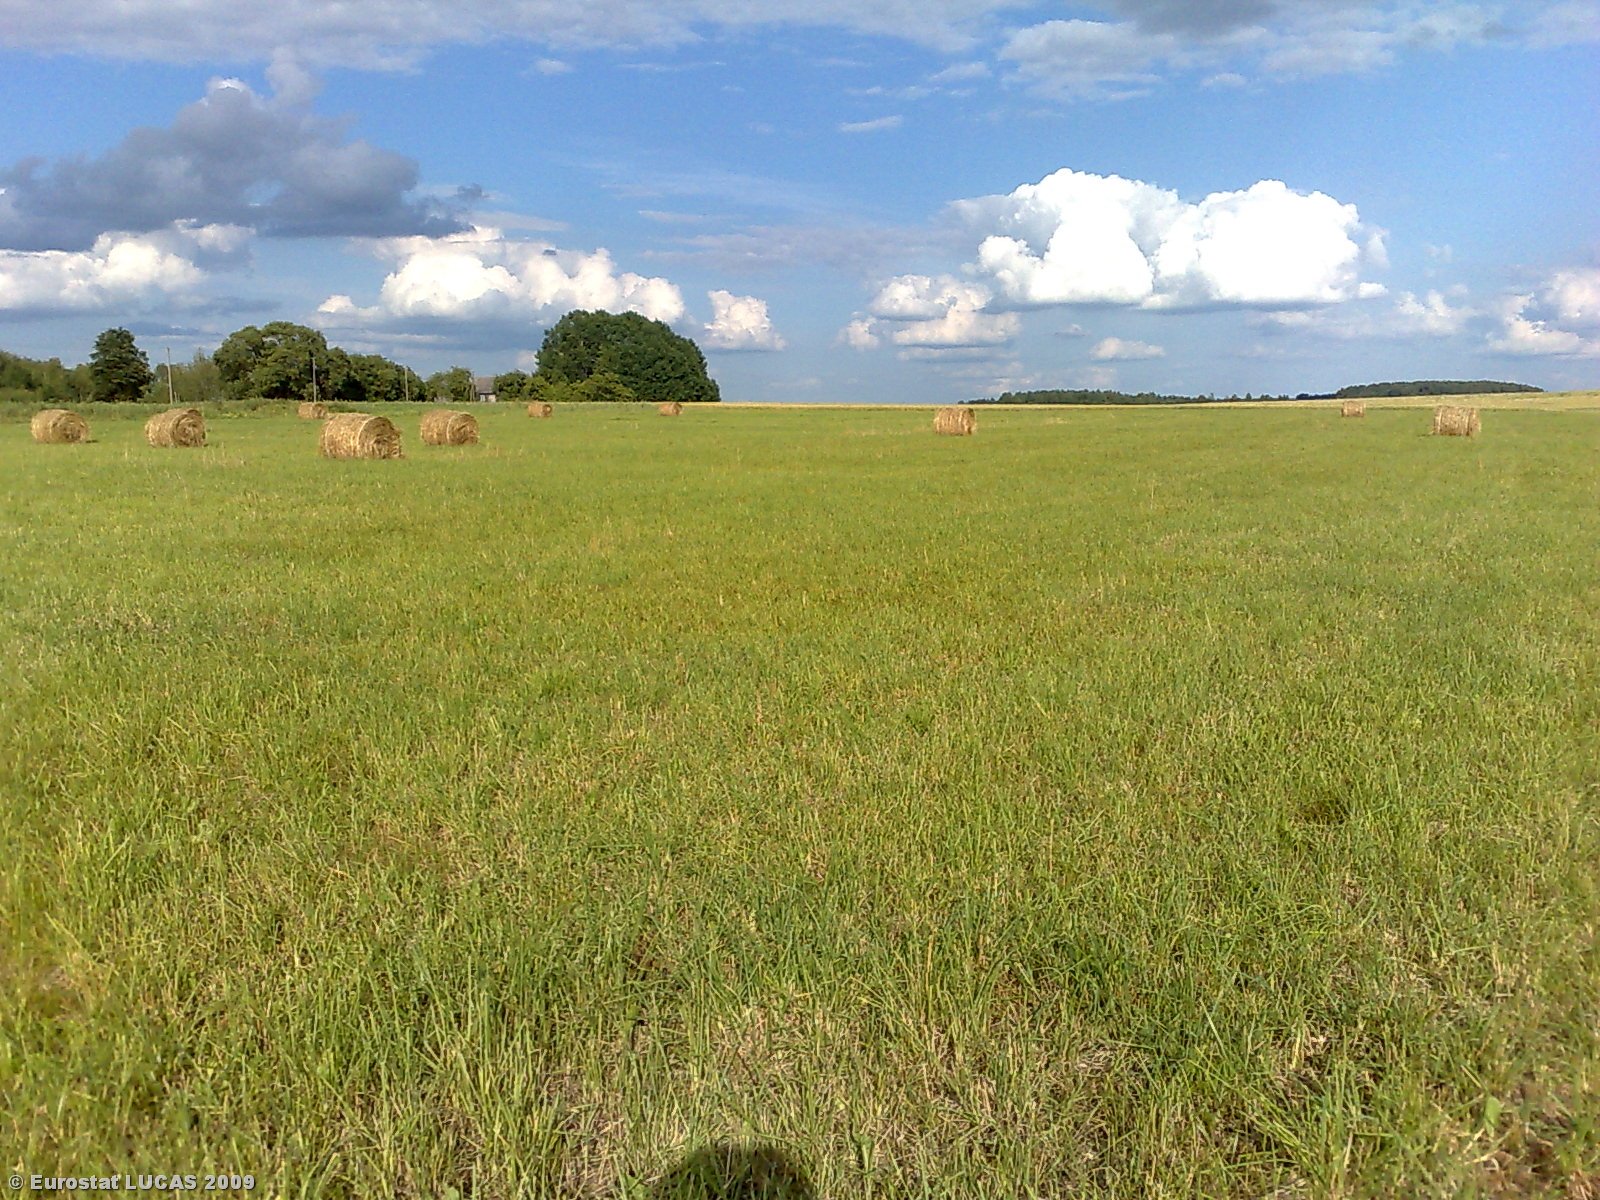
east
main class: Grassland
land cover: Grassland without tree/shrub cover
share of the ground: > 75 %
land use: Agriculture (excluding fallow land and kitchen gardens)
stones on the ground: < 10 %
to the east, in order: Grassland without tree/shrub cover; Common wheat
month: July
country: LT
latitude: 55.7269
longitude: 22.7872
